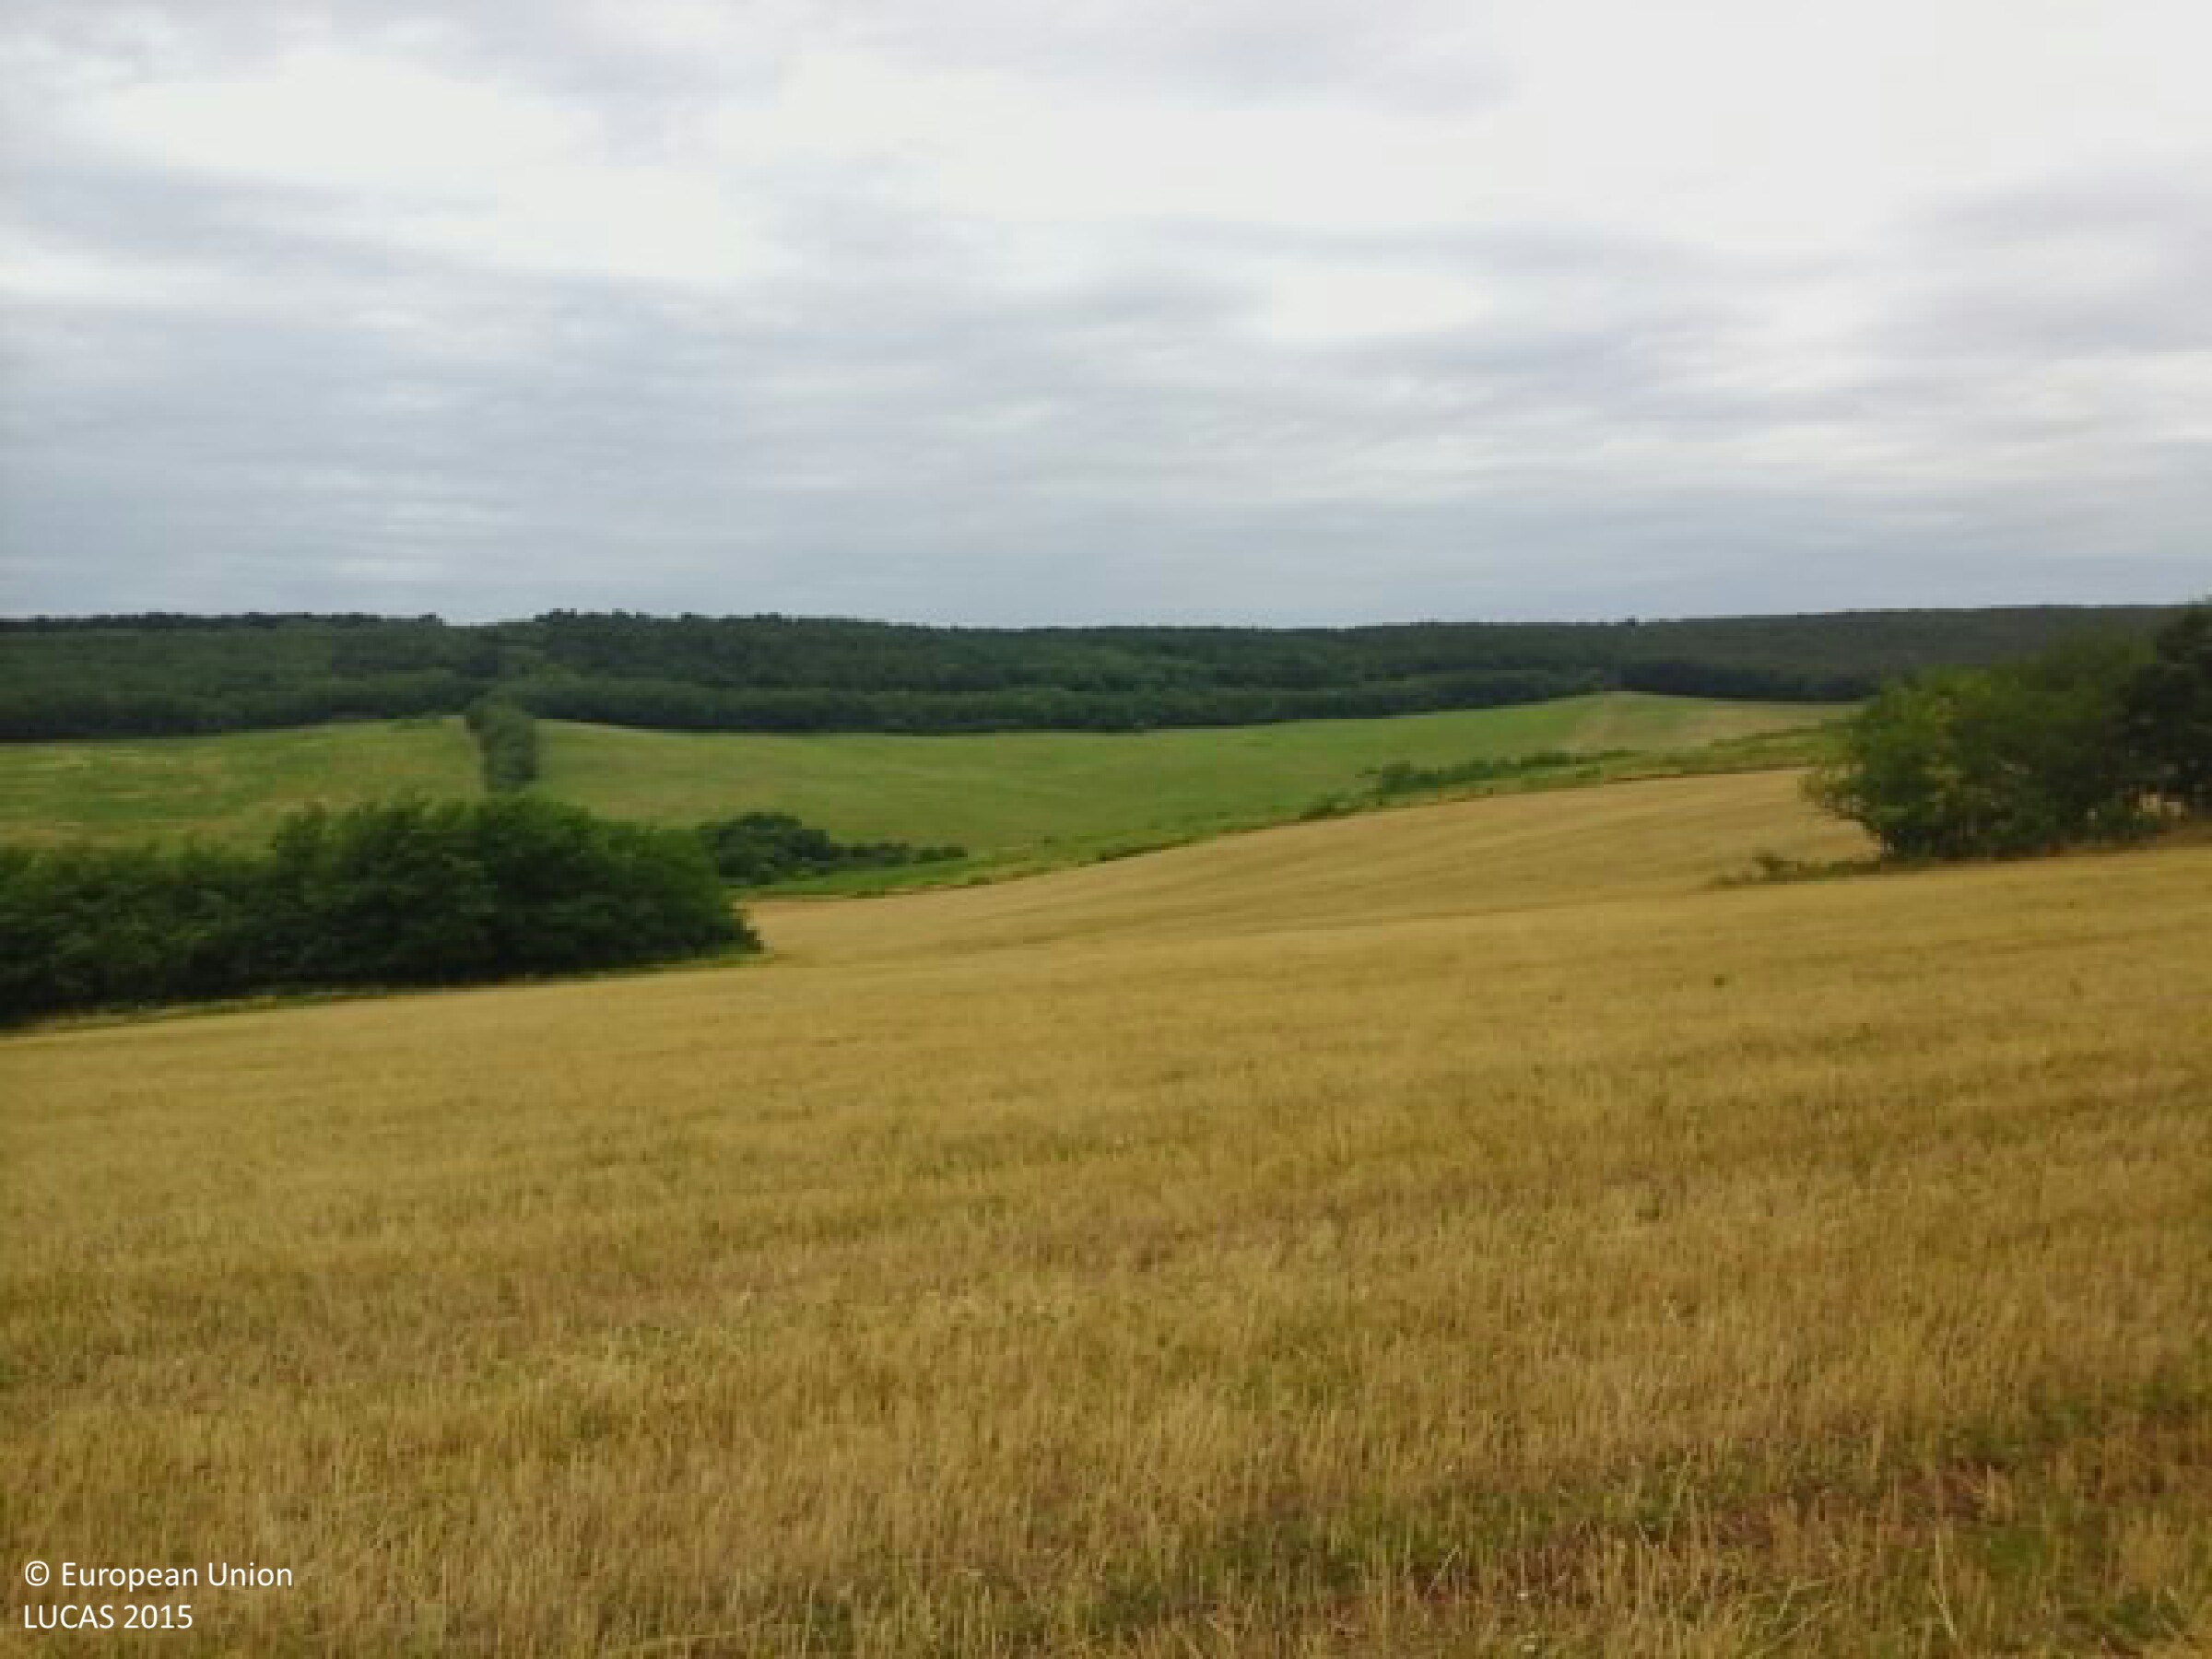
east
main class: Cropland
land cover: Common wheat
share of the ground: 50 - 75 %
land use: Agriculture (excluding fallow land and kitchen gardens)
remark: Harvested field
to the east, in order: Common wheat; Broadleaved woodland; Sunflower
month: July
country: HU
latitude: 47.7621
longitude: 19.4545
